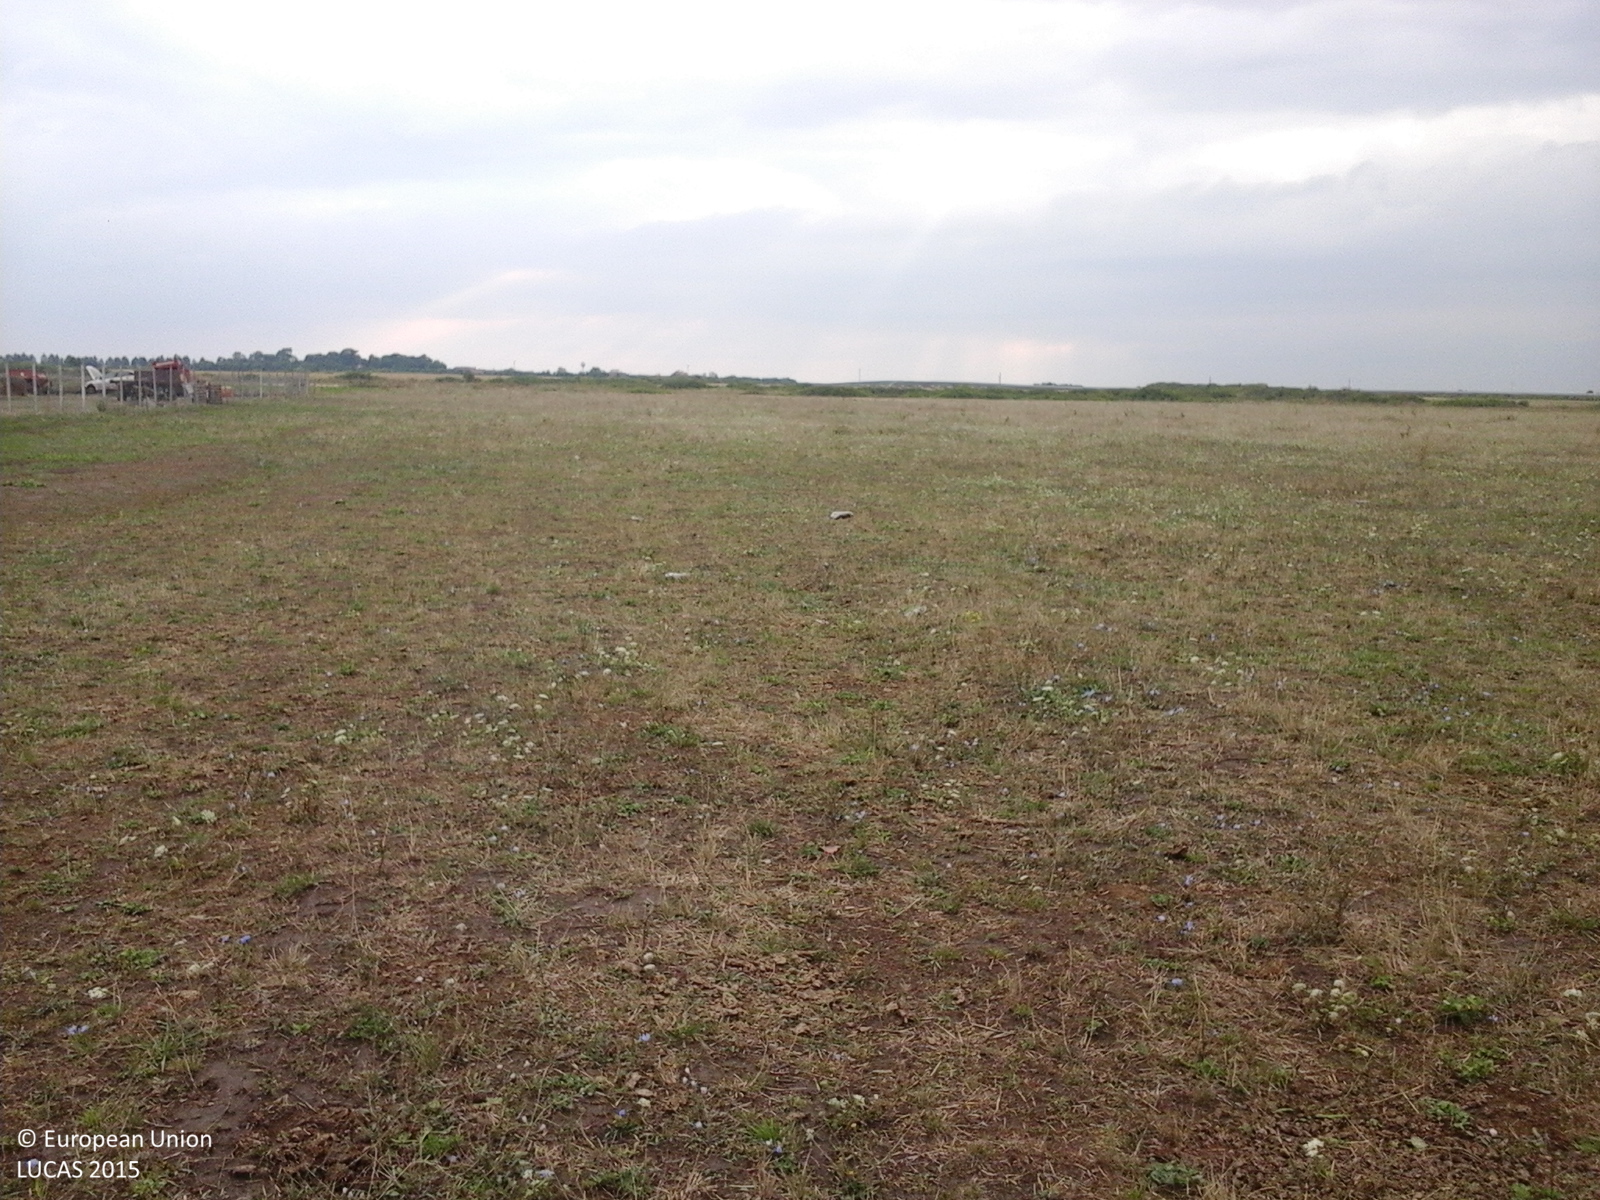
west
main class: Grassland
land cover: Grassland without tree/shrub cover
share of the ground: > 75 %
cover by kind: herbaceous plants 100 %
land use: Agriculture (excluding fallow land and kitchen gardens)
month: August
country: RO
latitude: 45.8072
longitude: 21.4472
